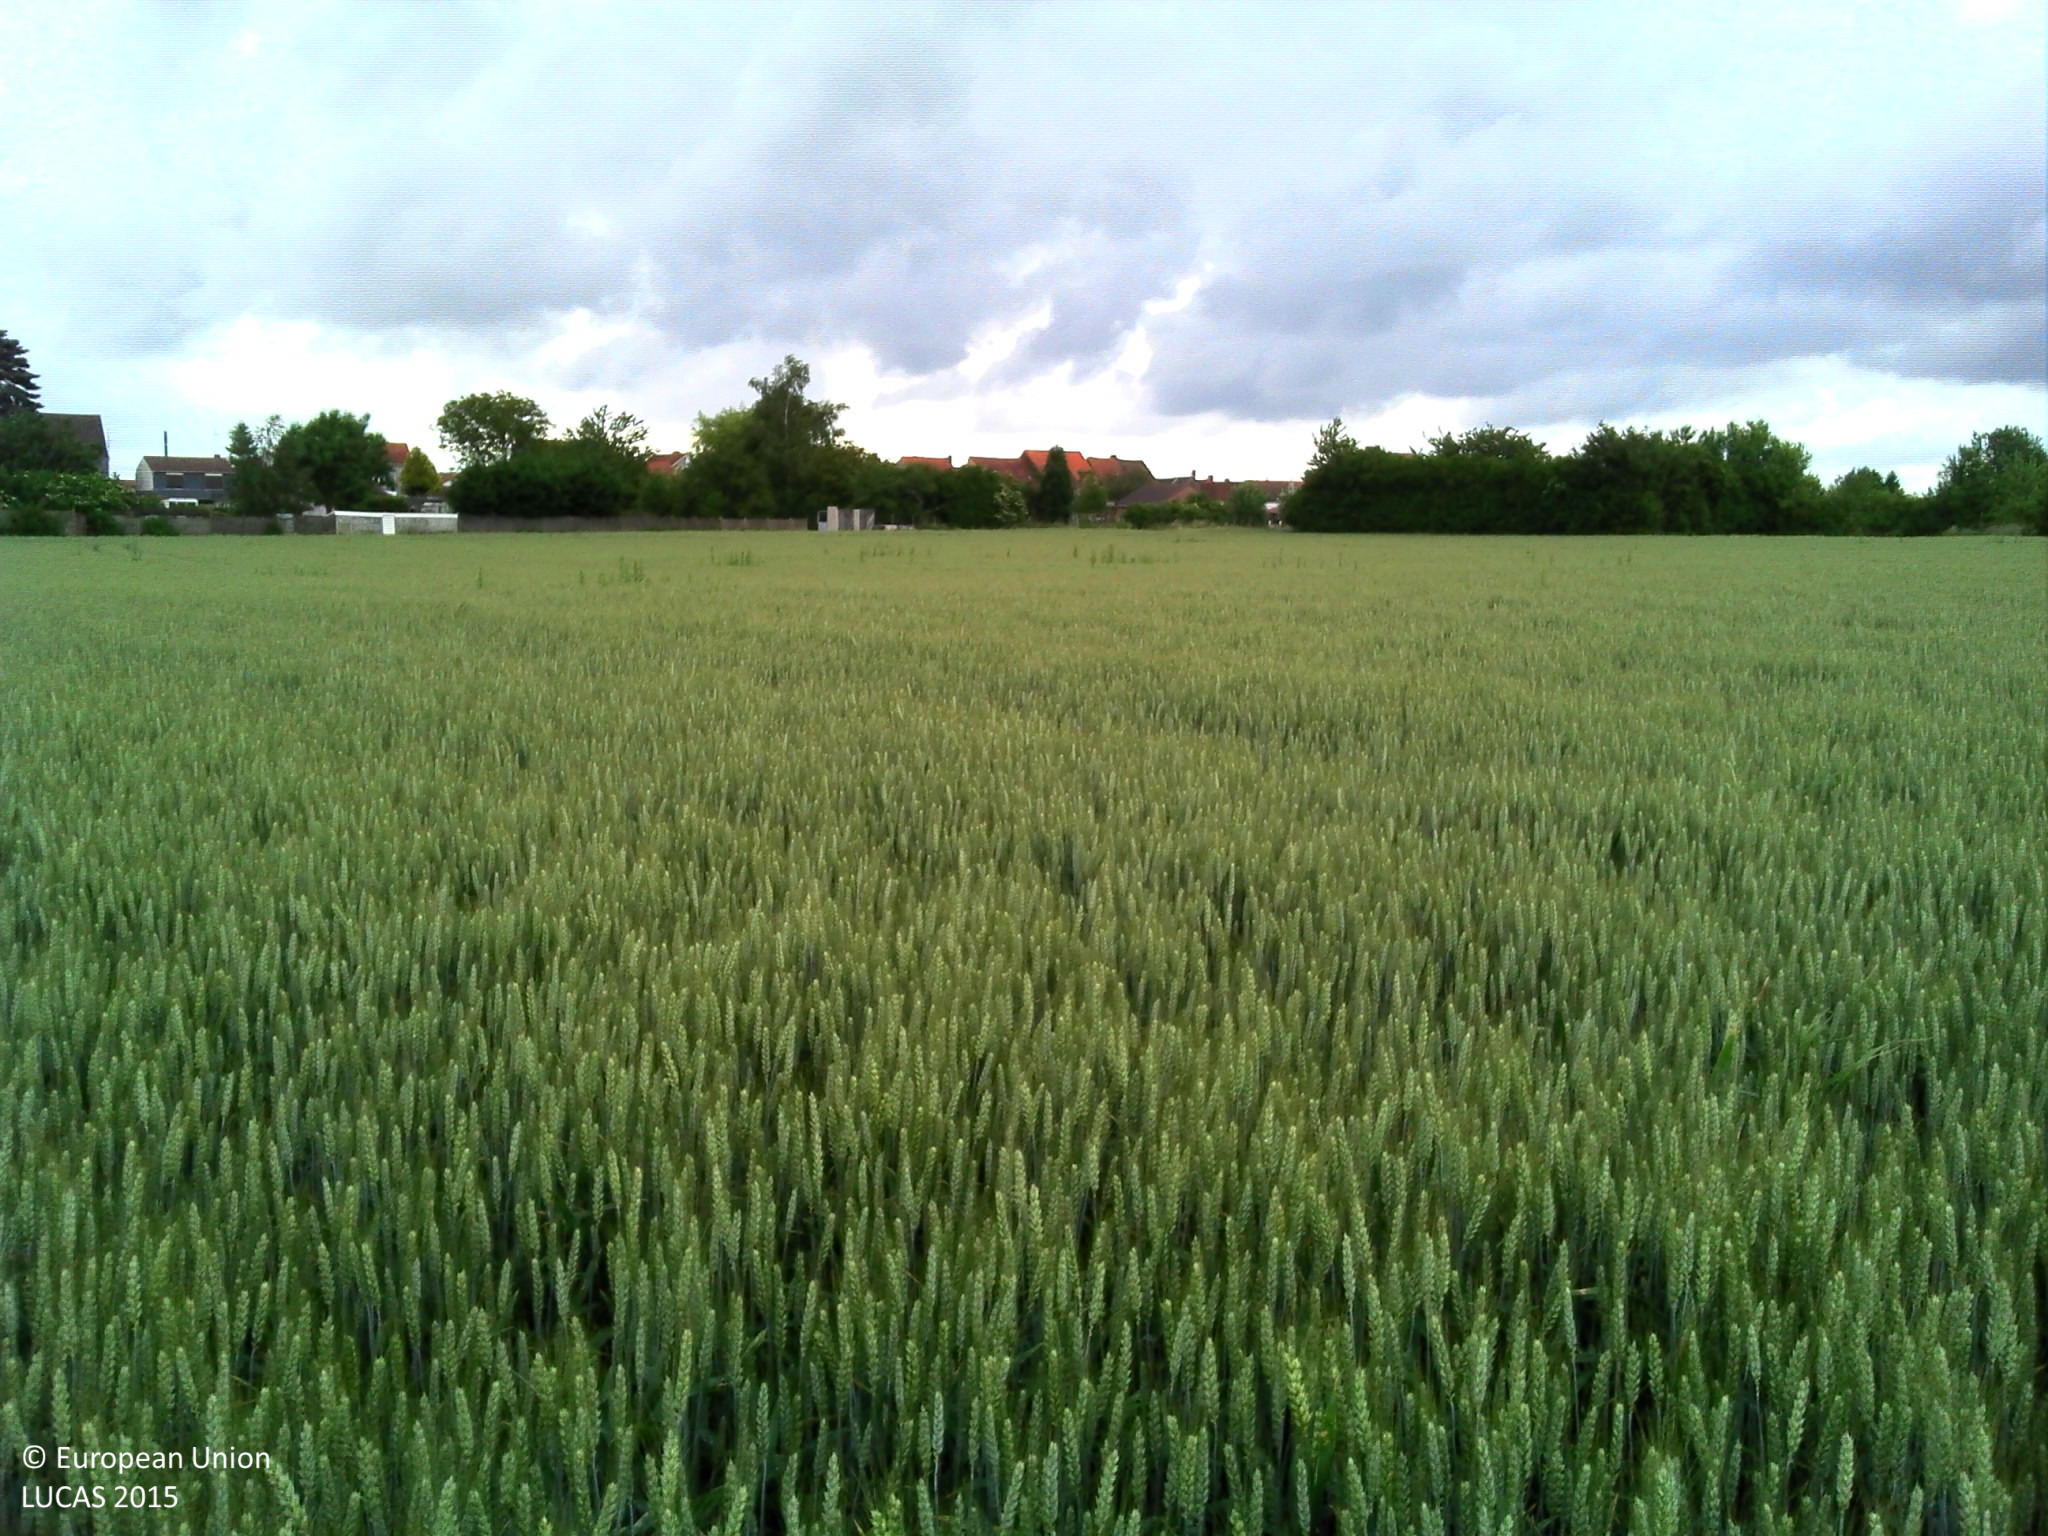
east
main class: Cropland
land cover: Common wheat
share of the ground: > 75 %
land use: Agriculture (excluding fallow land and kitchen gardens)
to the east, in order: Common wheat; Grass margins; Artificial constructions in urban areas
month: June
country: FR
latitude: 50.4952
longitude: 2.4736
